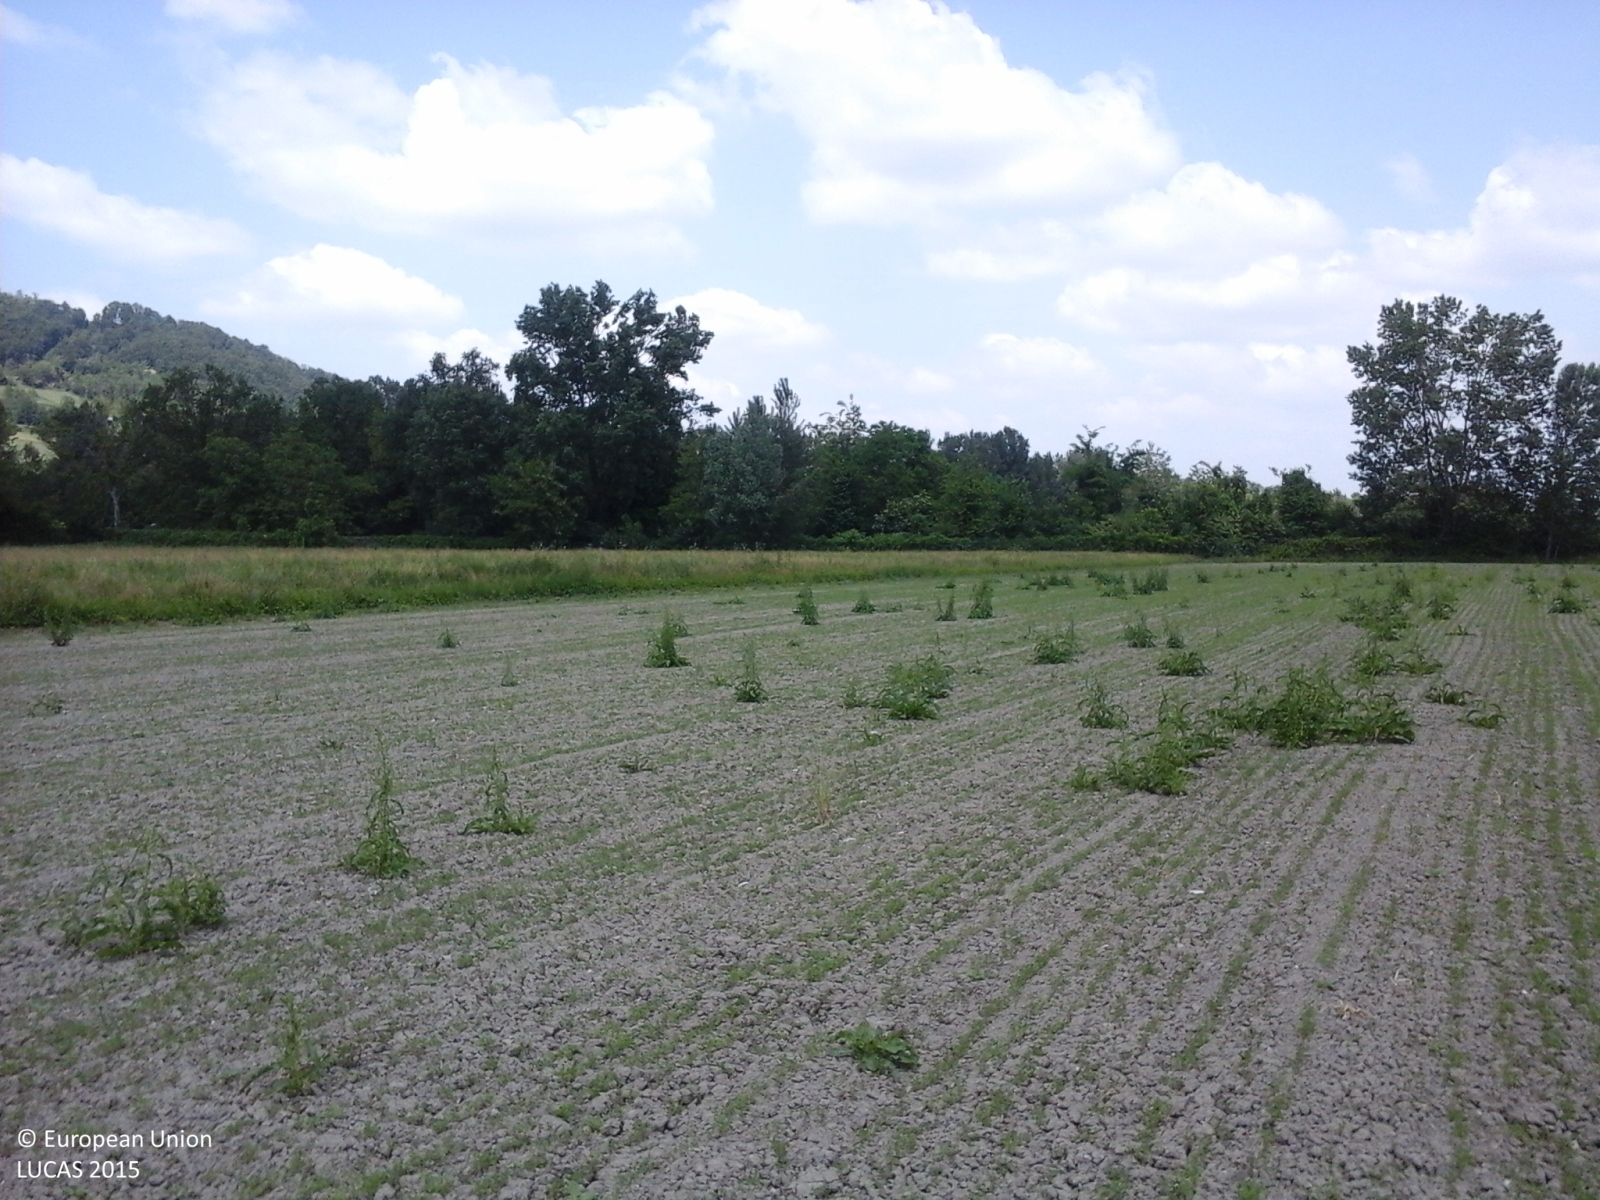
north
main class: Cropland
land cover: Lucerne
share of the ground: < 10 %
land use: Agriculture (excluding fallow land and kitchen gardens)
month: May
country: IT
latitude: 44.6570
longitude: 10.1888
